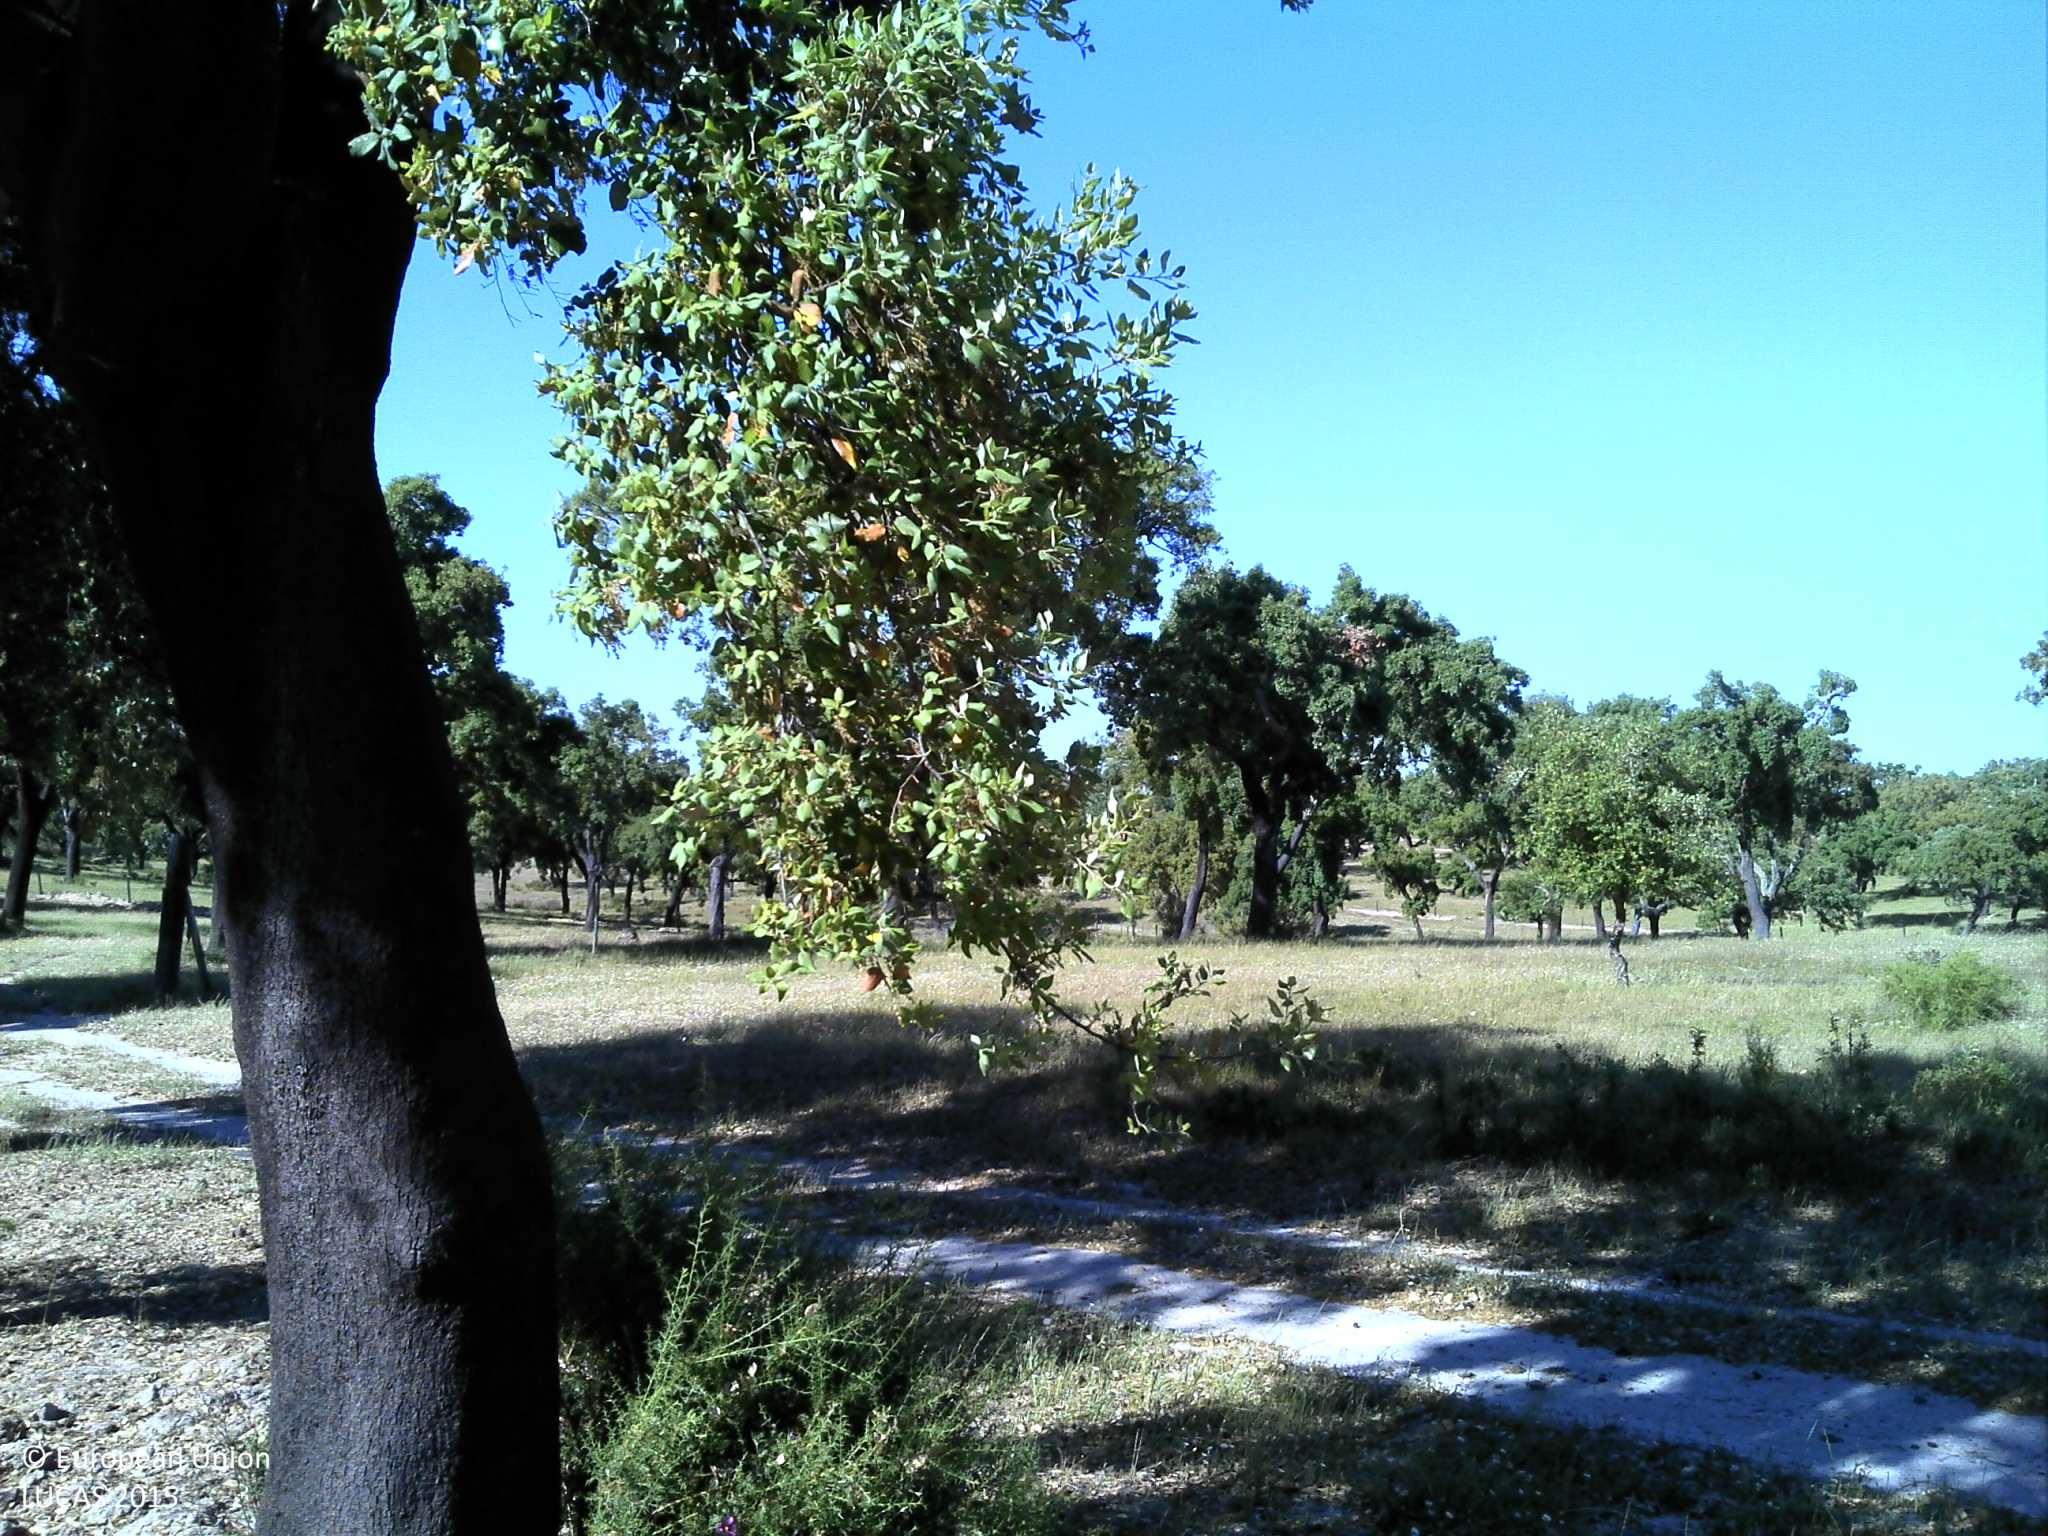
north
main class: Woodland
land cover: Broadleaved woodland
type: broadleaved evergreen forest
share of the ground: 25 - 50 %
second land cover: Grassland without tree/shrub cover
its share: 25 - 50 %
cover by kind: herbaceous plants 40 %, broadleaved forest trees 30 %, unconsolidated bare surface 30 %
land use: Forestry
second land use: Agriculture (excluding fallow land and kitchen gardens)
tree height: > 5 m
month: May
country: PT
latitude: 39.2425
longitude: -7.9542
